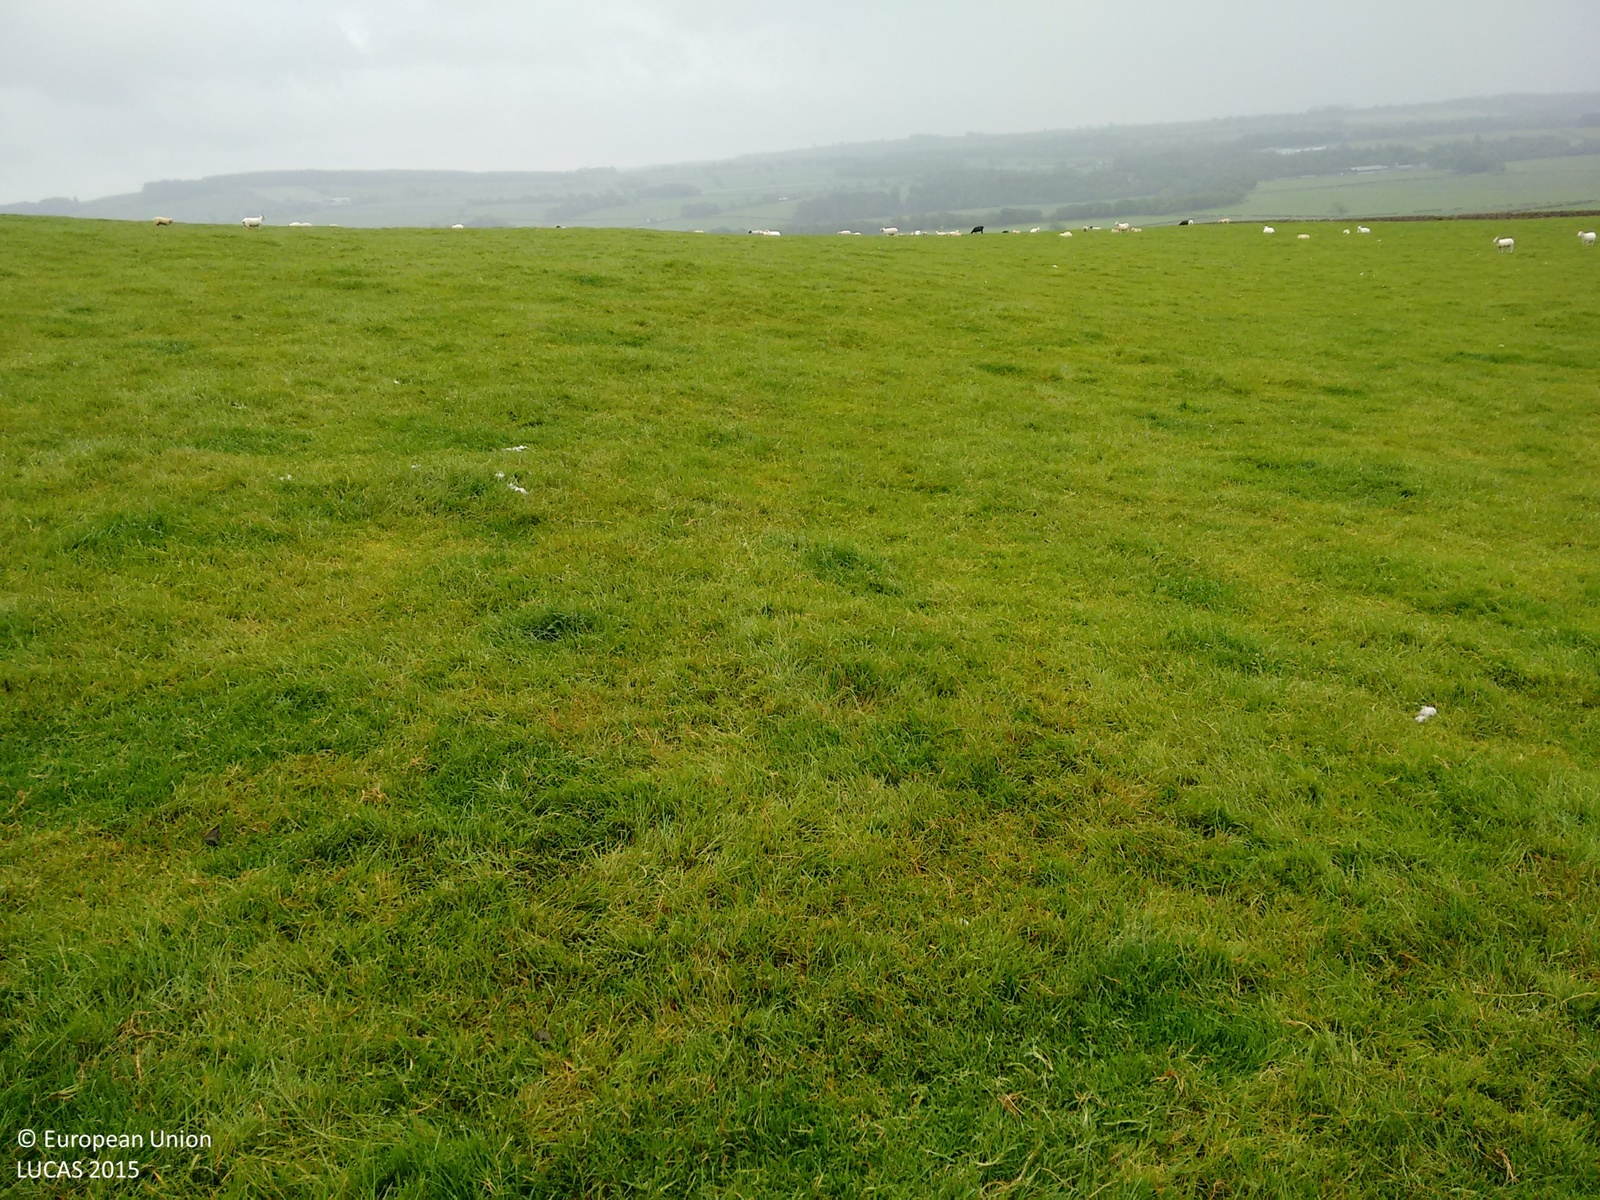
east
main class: Grassland
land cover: Grassland without tree/shrub cover
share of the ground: > 75 %
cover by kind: herbaceous plants 100 %
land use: Agriculture (excluding fallow land and kitchen gardens)
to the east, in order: Grassland without tree/shrub cover
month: June
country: GB
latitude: 55.0353
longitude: -3.2981
